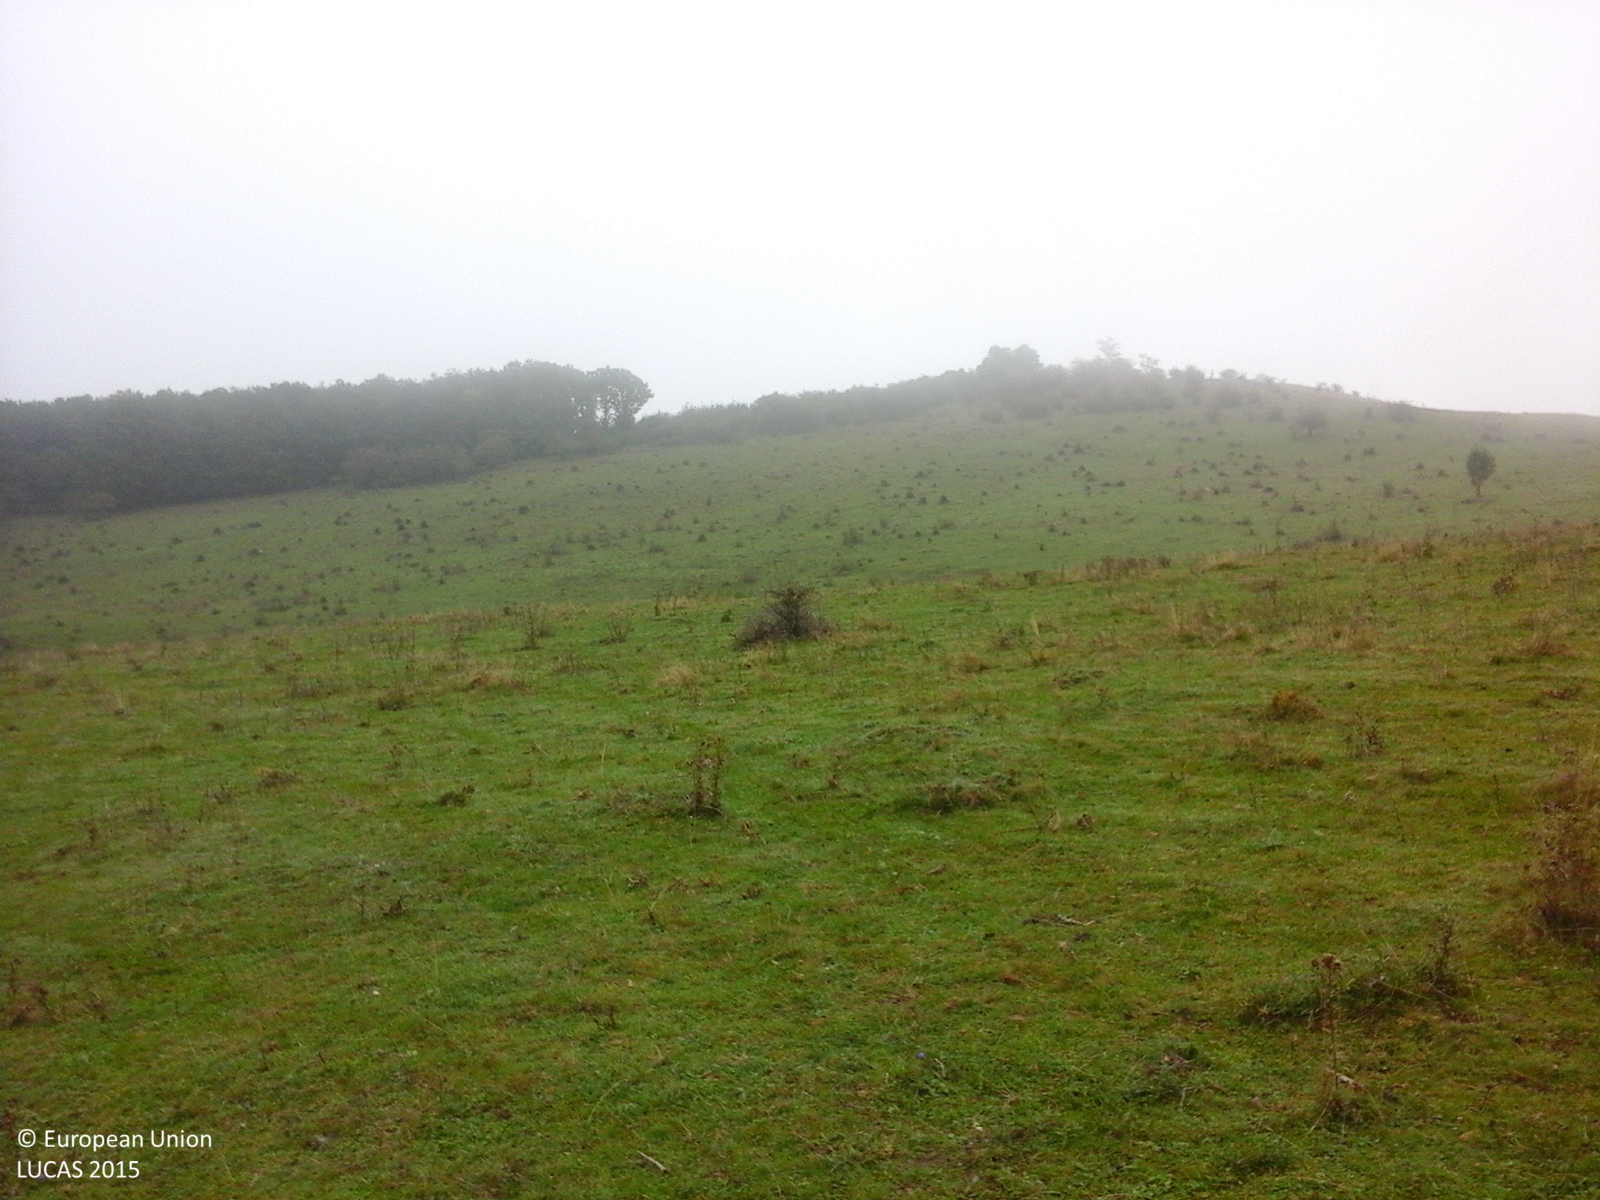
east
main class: Grassland
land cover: Grassland with sparse tree/shrub cover
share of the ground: > 75 %
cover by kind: herbaceous plants 95 %, broadleaved forest trees 5 %
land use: Agriculture (excluding fallow land and kitchen gardens)
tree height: < 5 m
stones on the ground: < 10 %
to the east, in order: Grassland with sparse tree/shrub cover
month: October
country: RO
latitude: 46.6723
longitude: 24.3726
